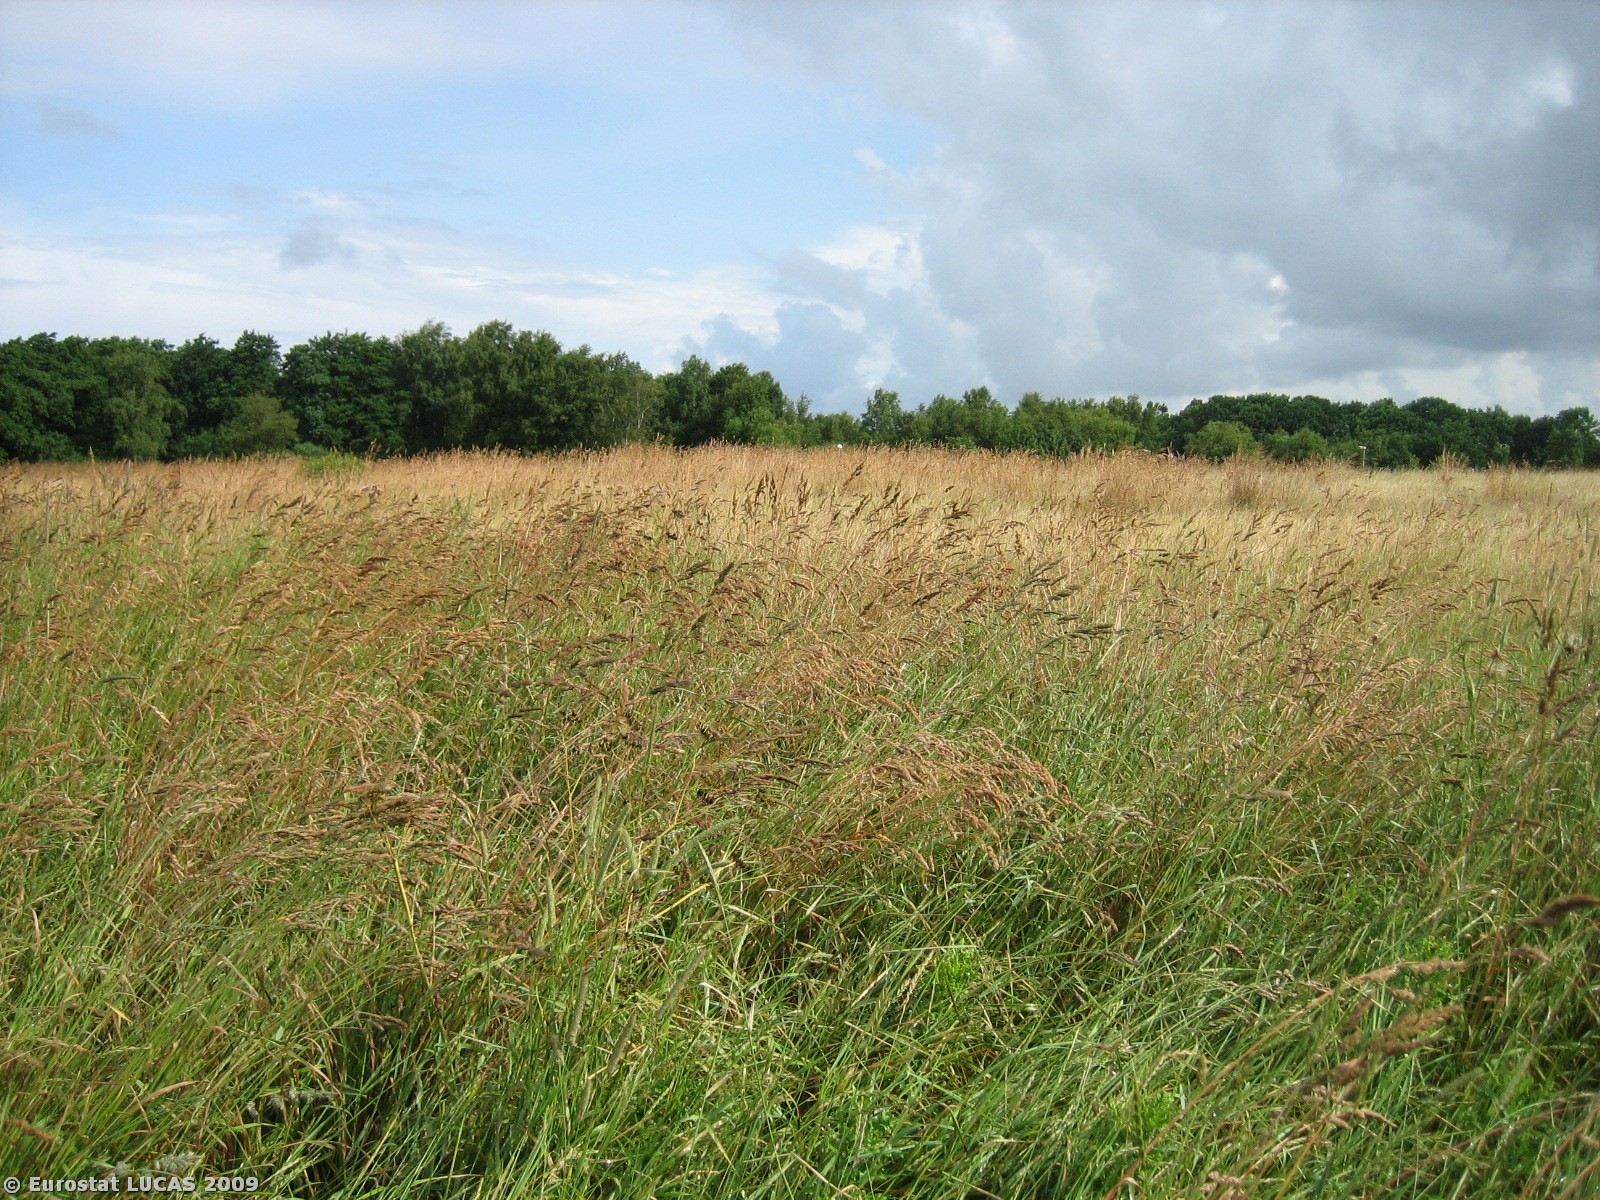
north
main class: Grassland
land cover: Grassland without tree/shrub cover
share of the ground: > 75 %
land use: Amenities, museums, leisure
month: July
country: DK
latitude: 55.5130
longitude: 8.4336
